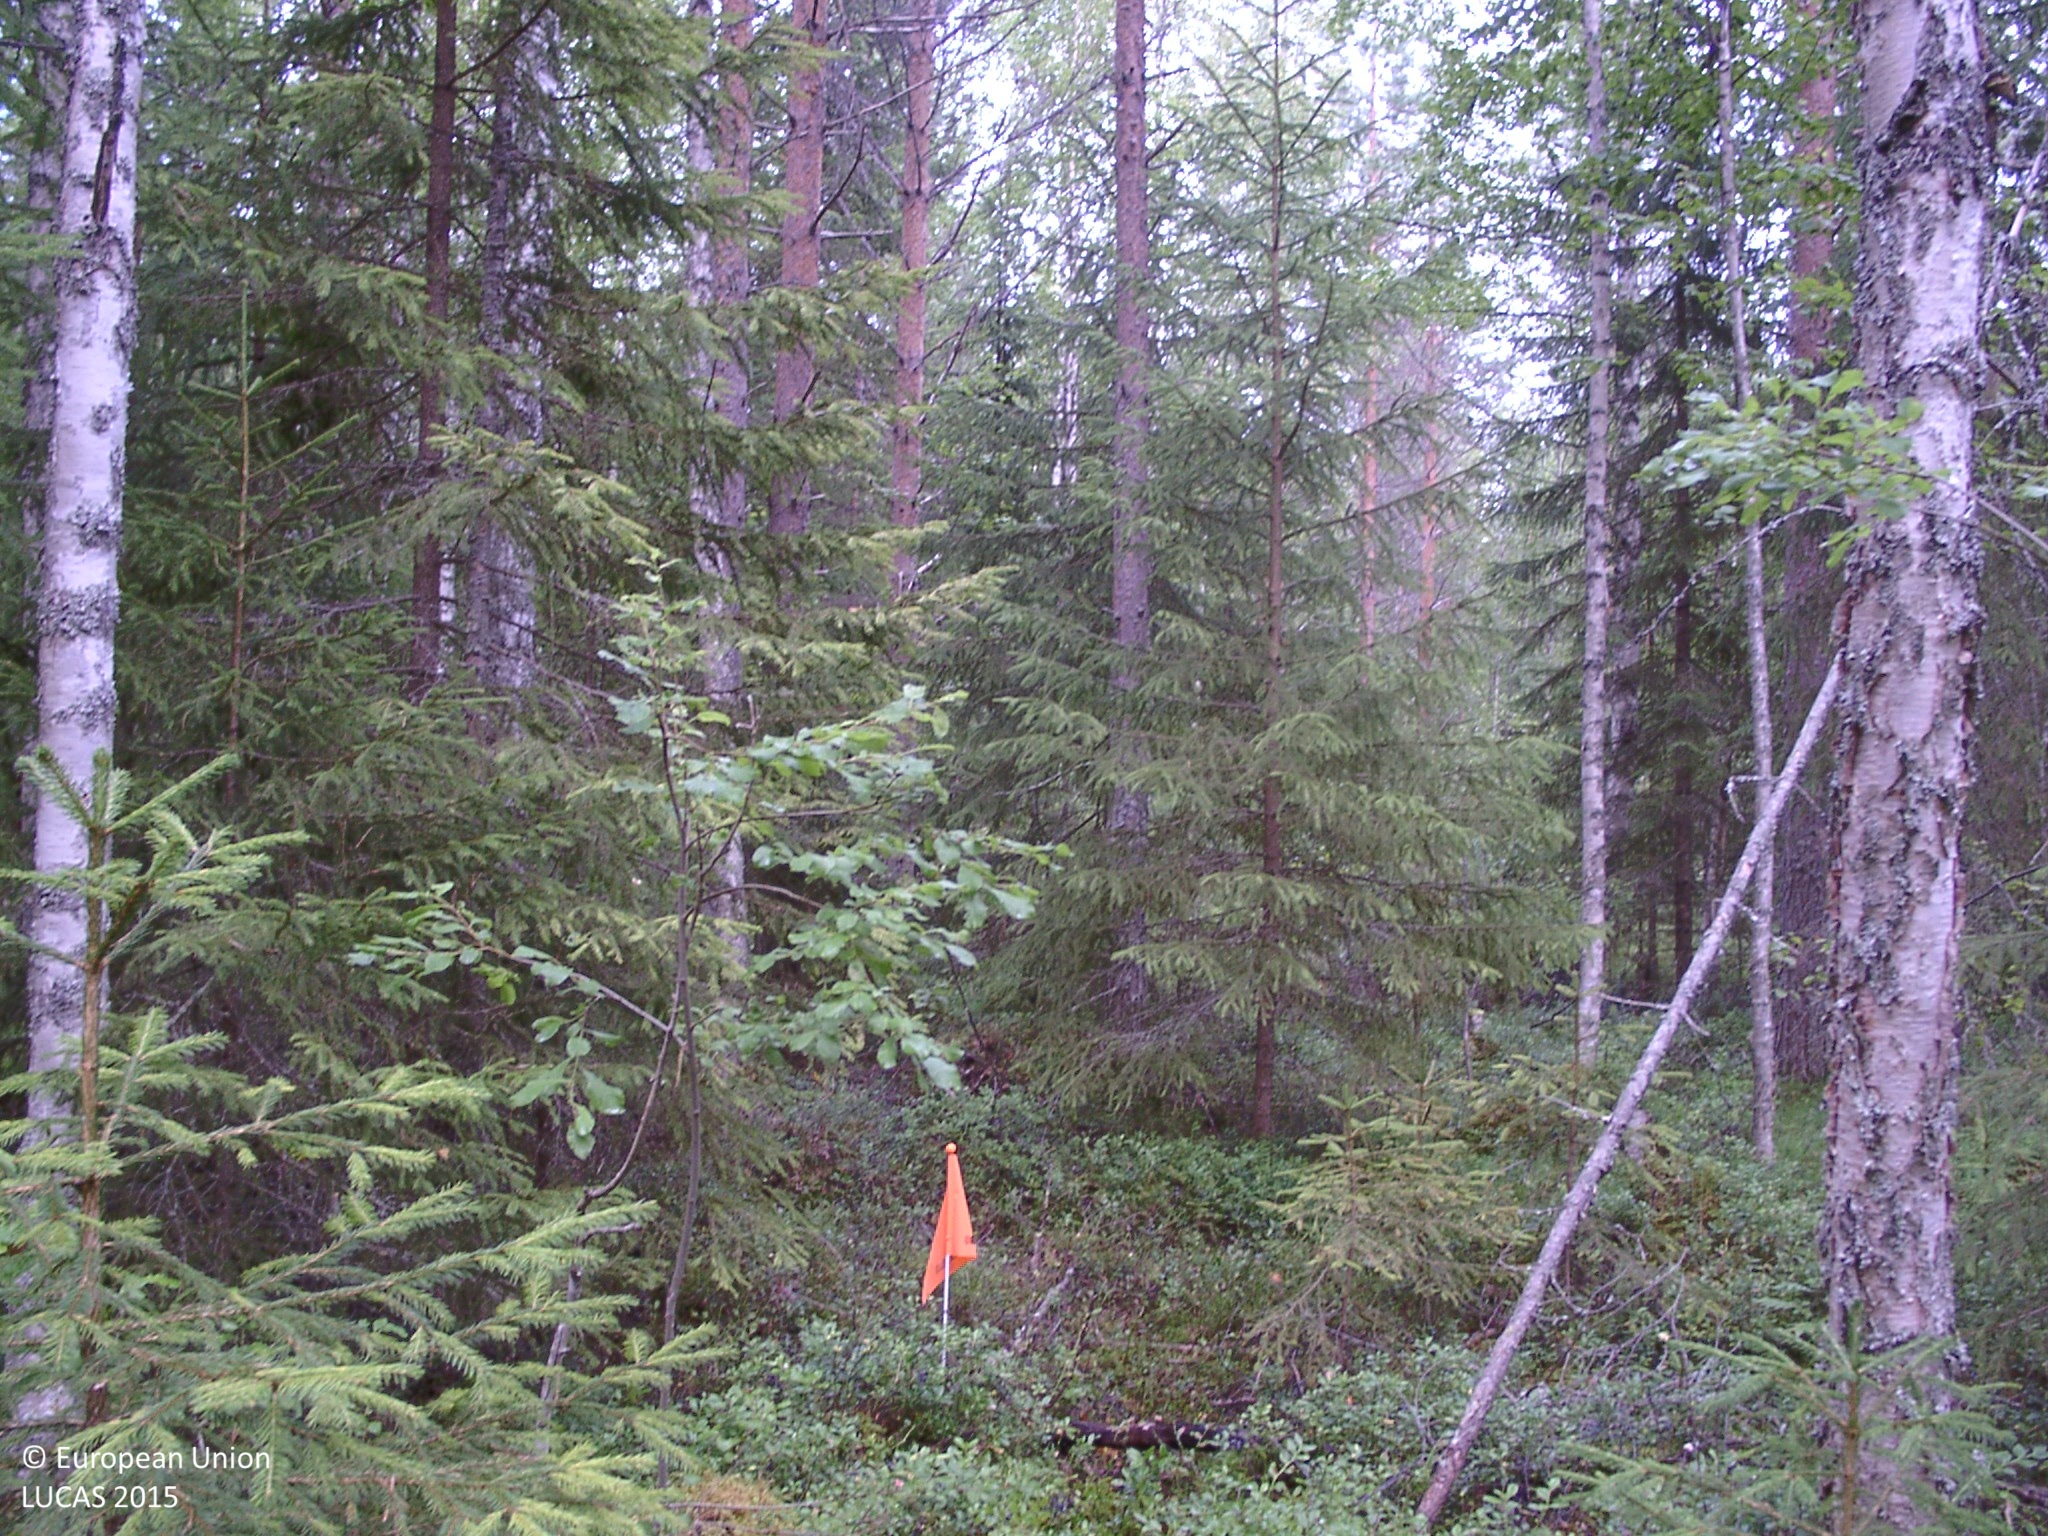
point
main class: Woodland
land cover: Other mixed woodland
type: boreal forest
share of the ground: > 75 %
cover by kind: coniferous forest trees 45 %, broadleaved forest trees 30 %, shrubs 20 %, lichens and mosses 5 %
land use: Forestry
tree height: > 5 m
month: August
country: FI
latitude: 63.0069
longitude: 25.0861
